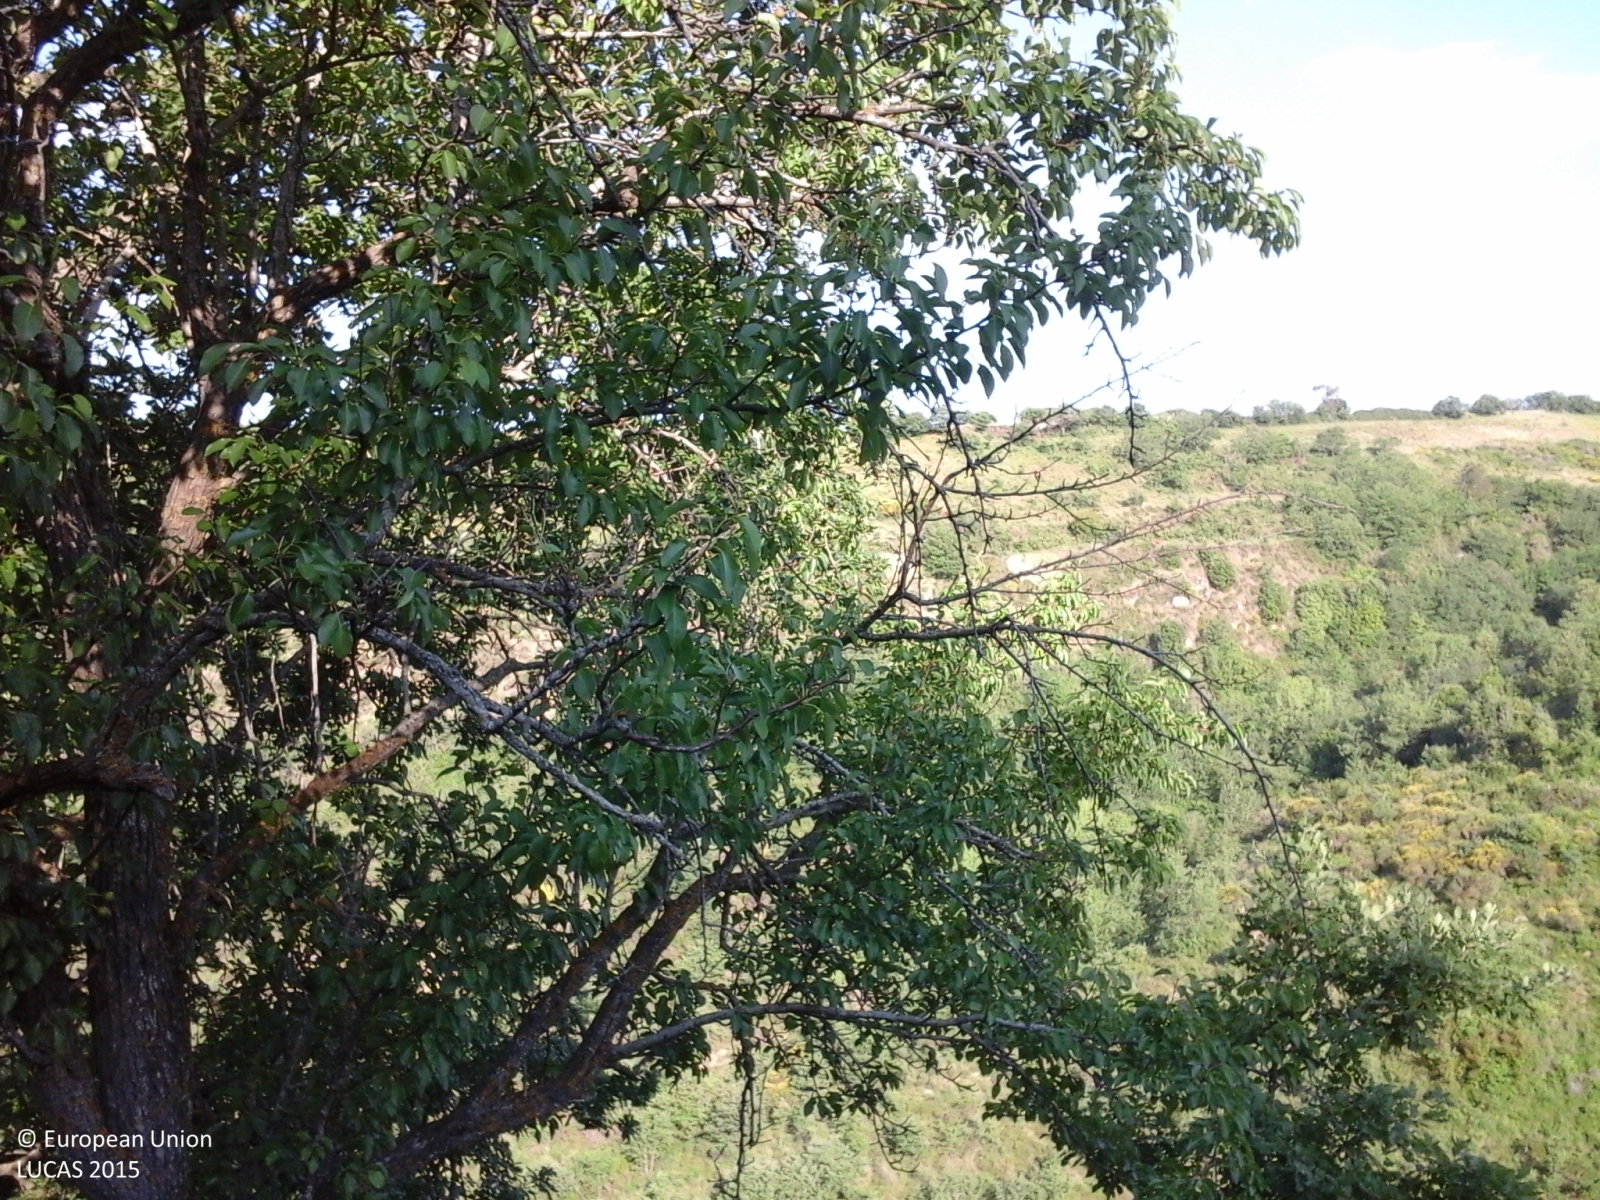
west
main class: Woodland
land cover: Broadleaved woodland
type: broadleaved evergreen forest
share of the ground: > 75 %
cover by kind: broadleaved forest trees 90 %, shrubs 10 %
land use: Forestry
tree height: > 5 m
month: June
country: IT
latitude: 37.3909
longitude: 14.4059
